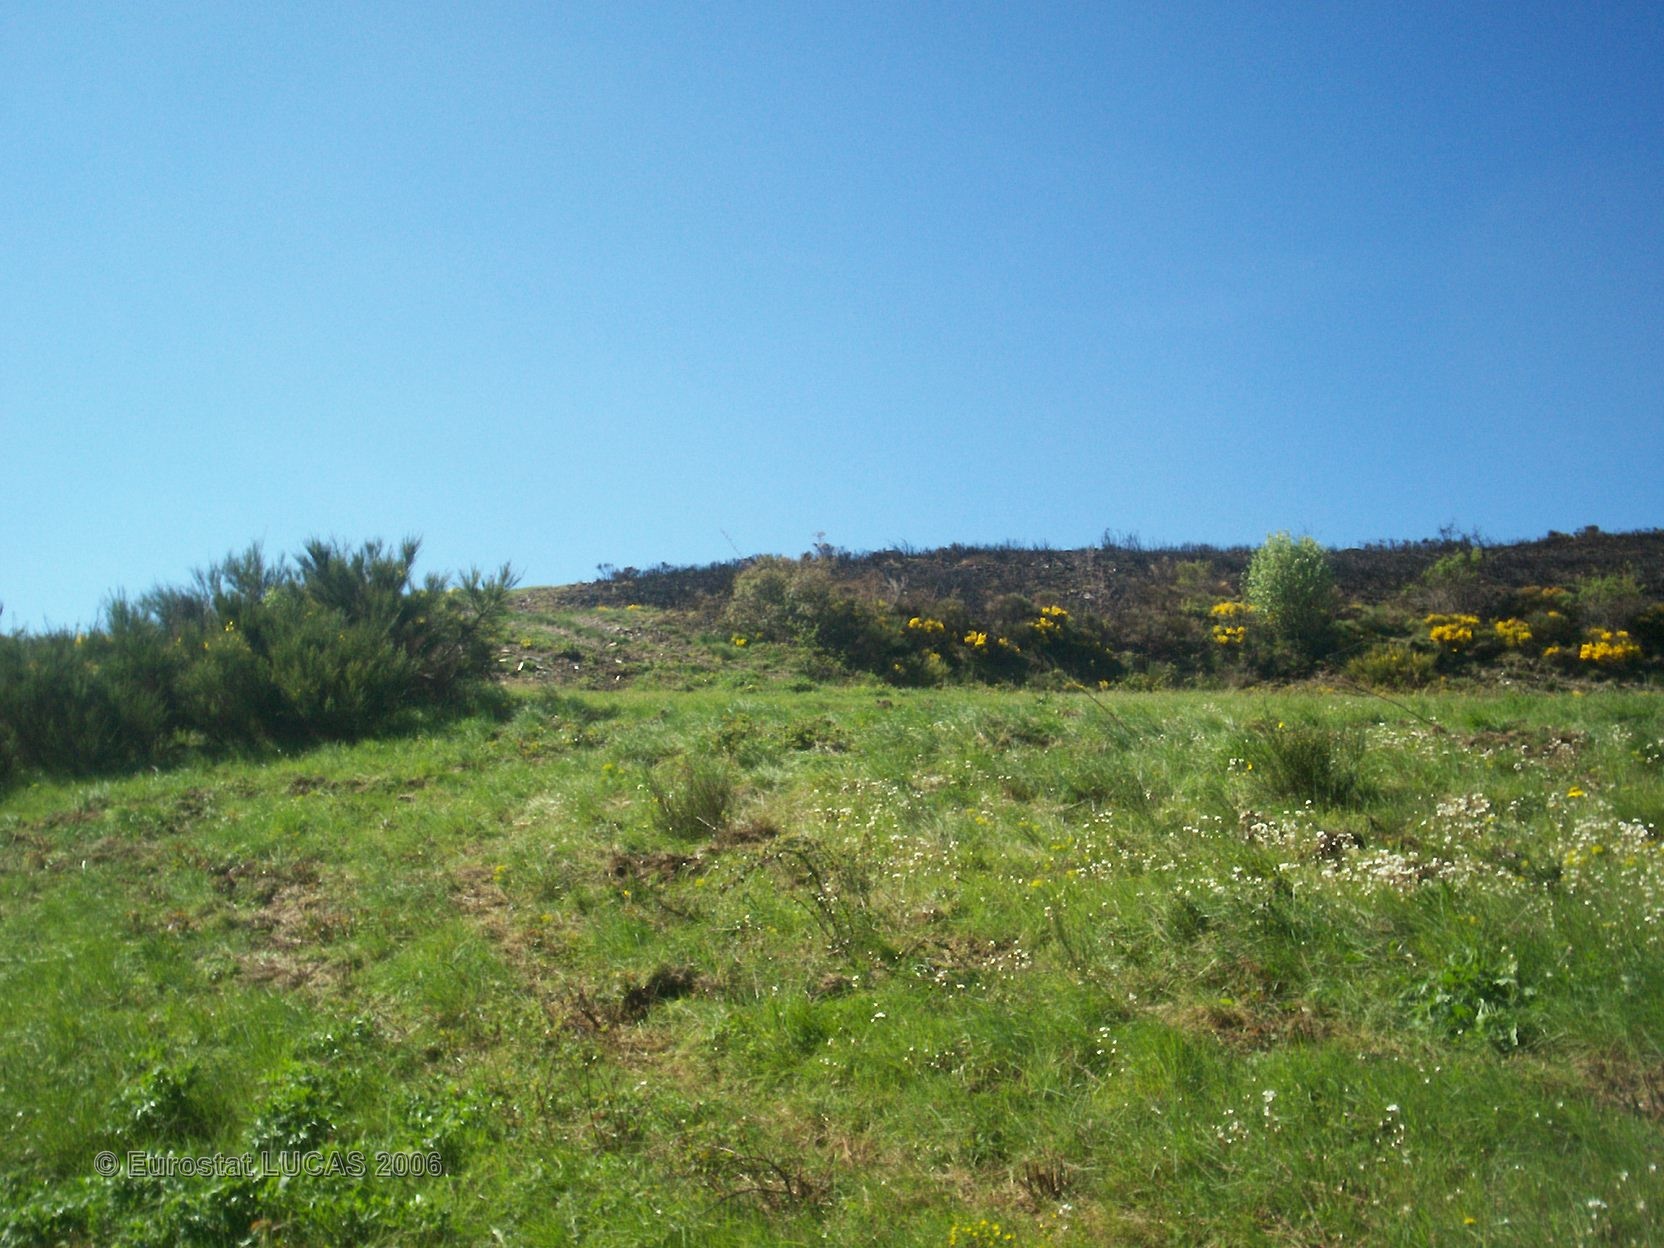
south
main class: Grassland
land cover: Grassland without tree/shrub cover
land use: Agriculture (excluding fallow land and kitchen gardens)
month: May
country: FR
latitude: 43.9799
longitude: 3.4372
